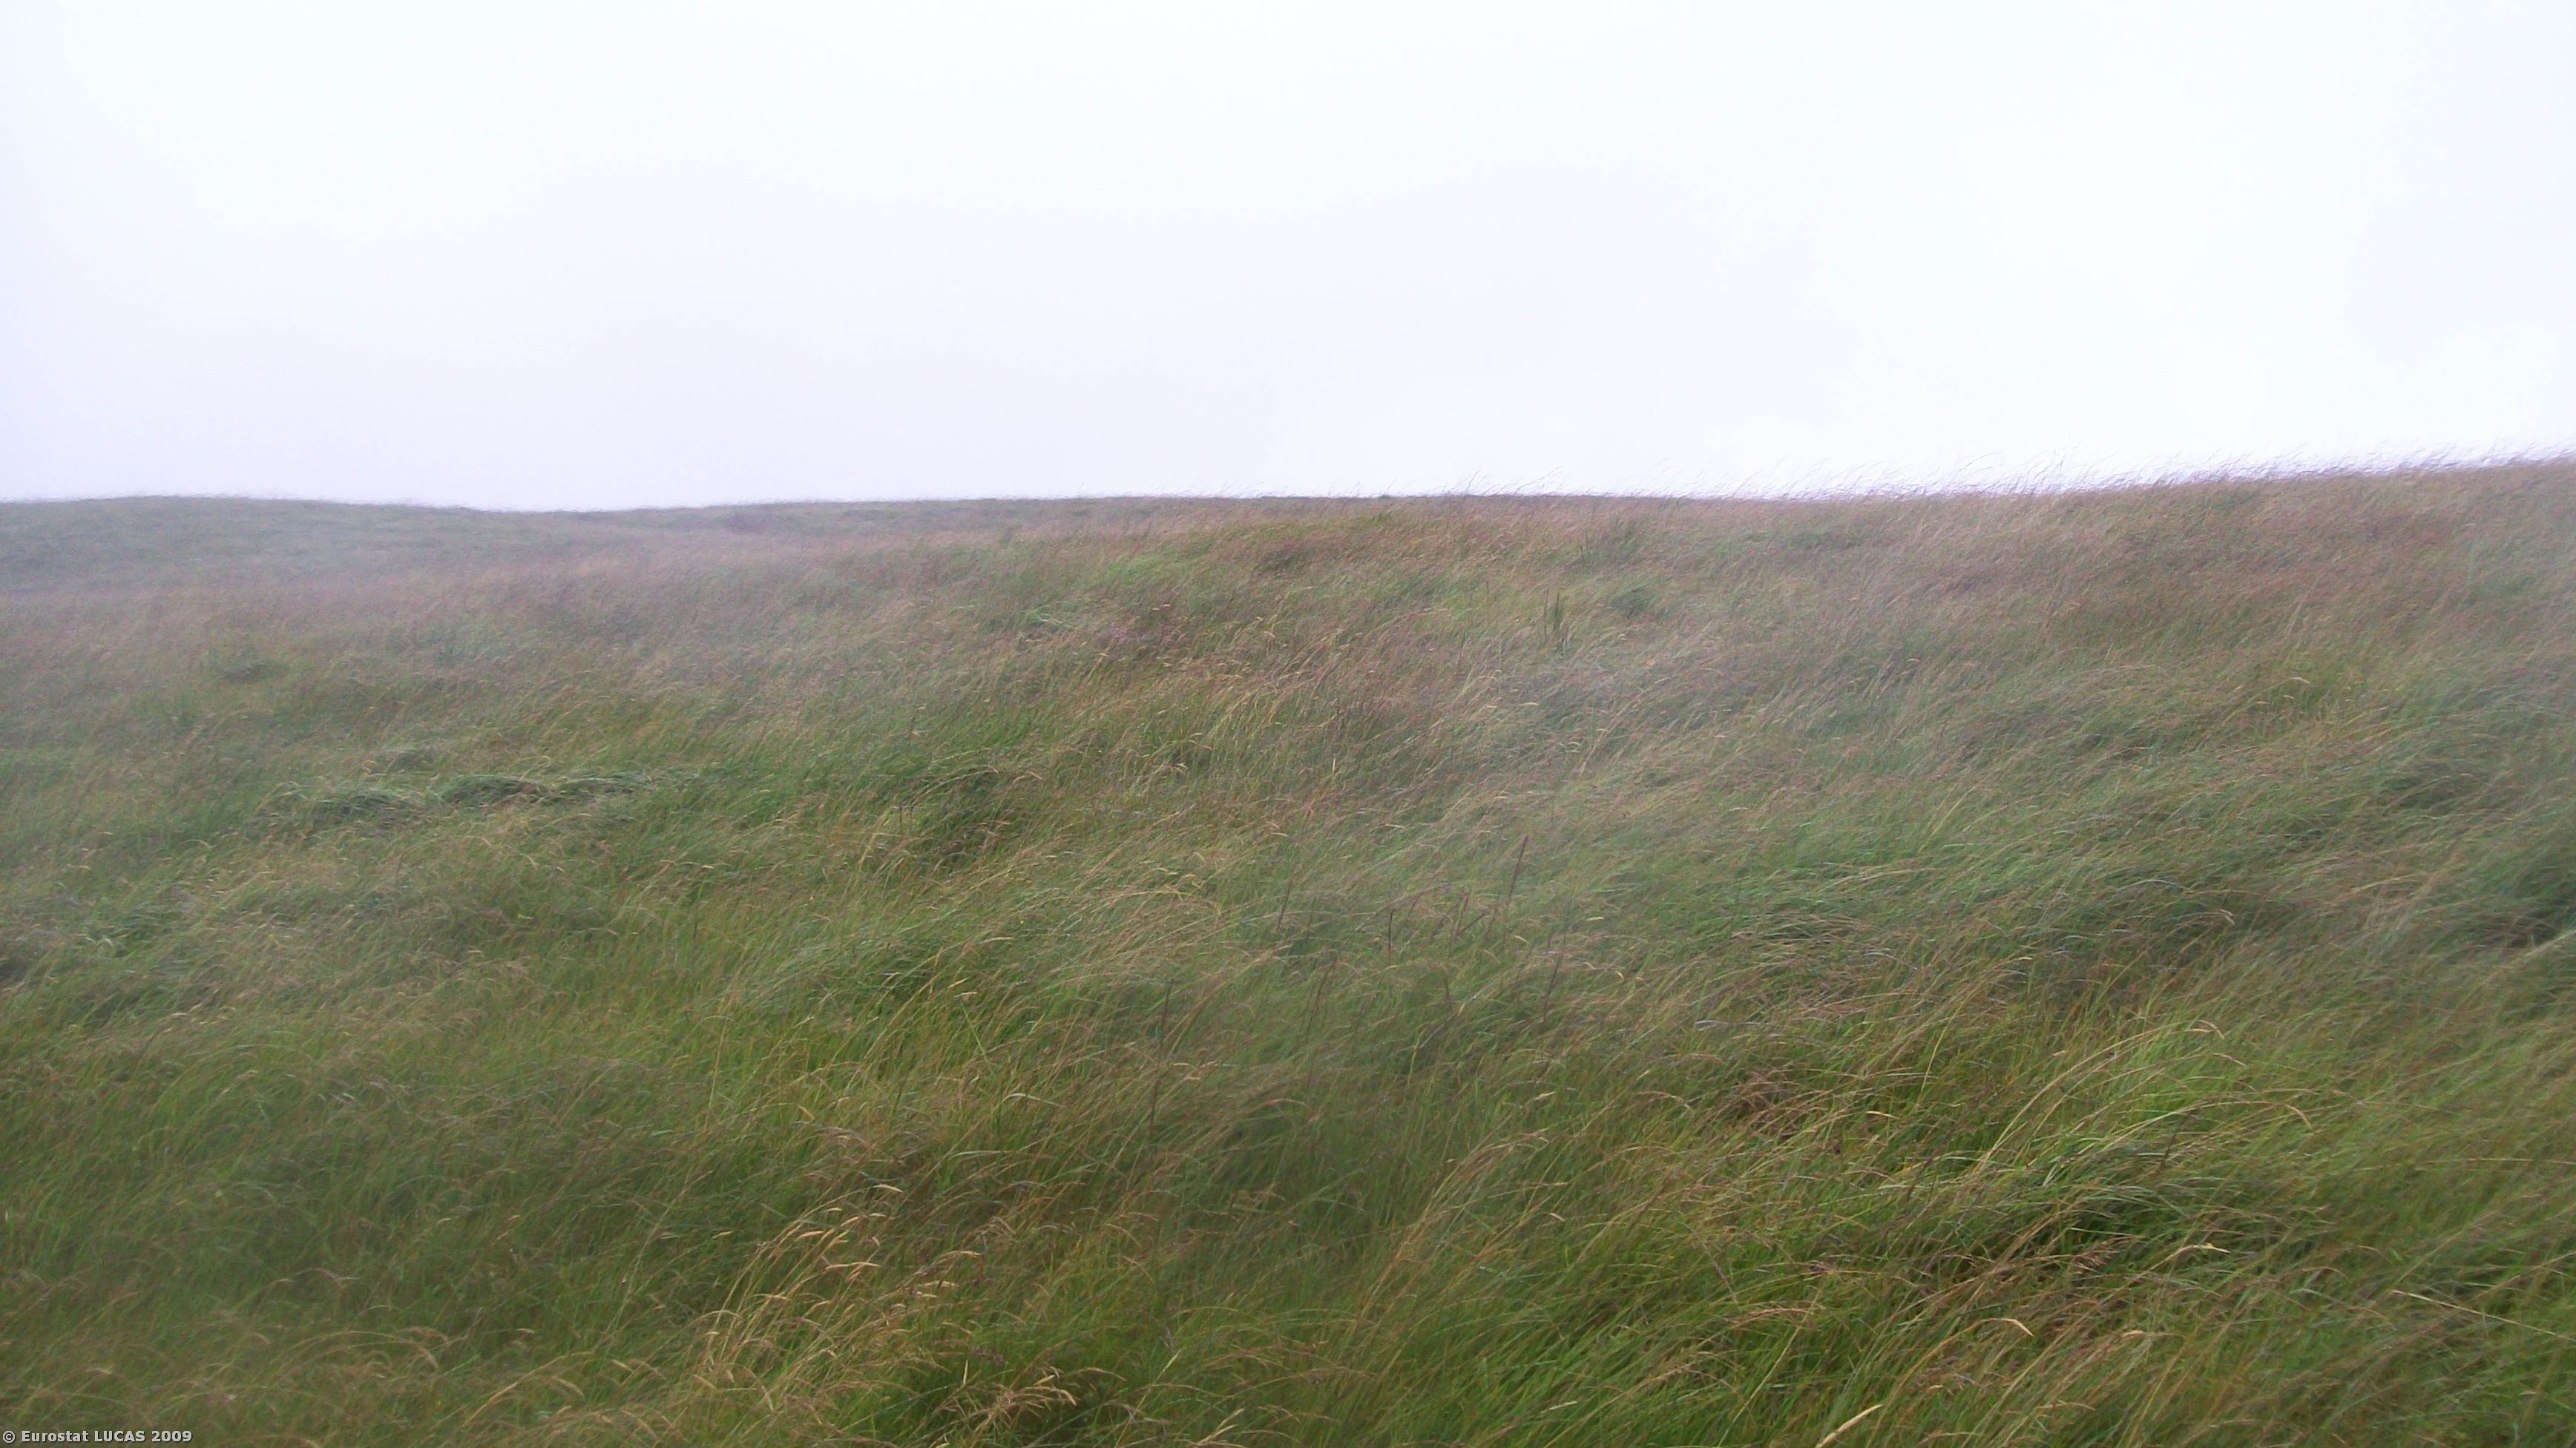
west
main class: Grassland
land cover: Grassland without tree/shrub cover
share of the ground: > 75 %
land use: Agriculture (excluding fallow land and kitchen gardens)
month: August
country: GB
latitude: 55.4723
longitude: -3.4779
